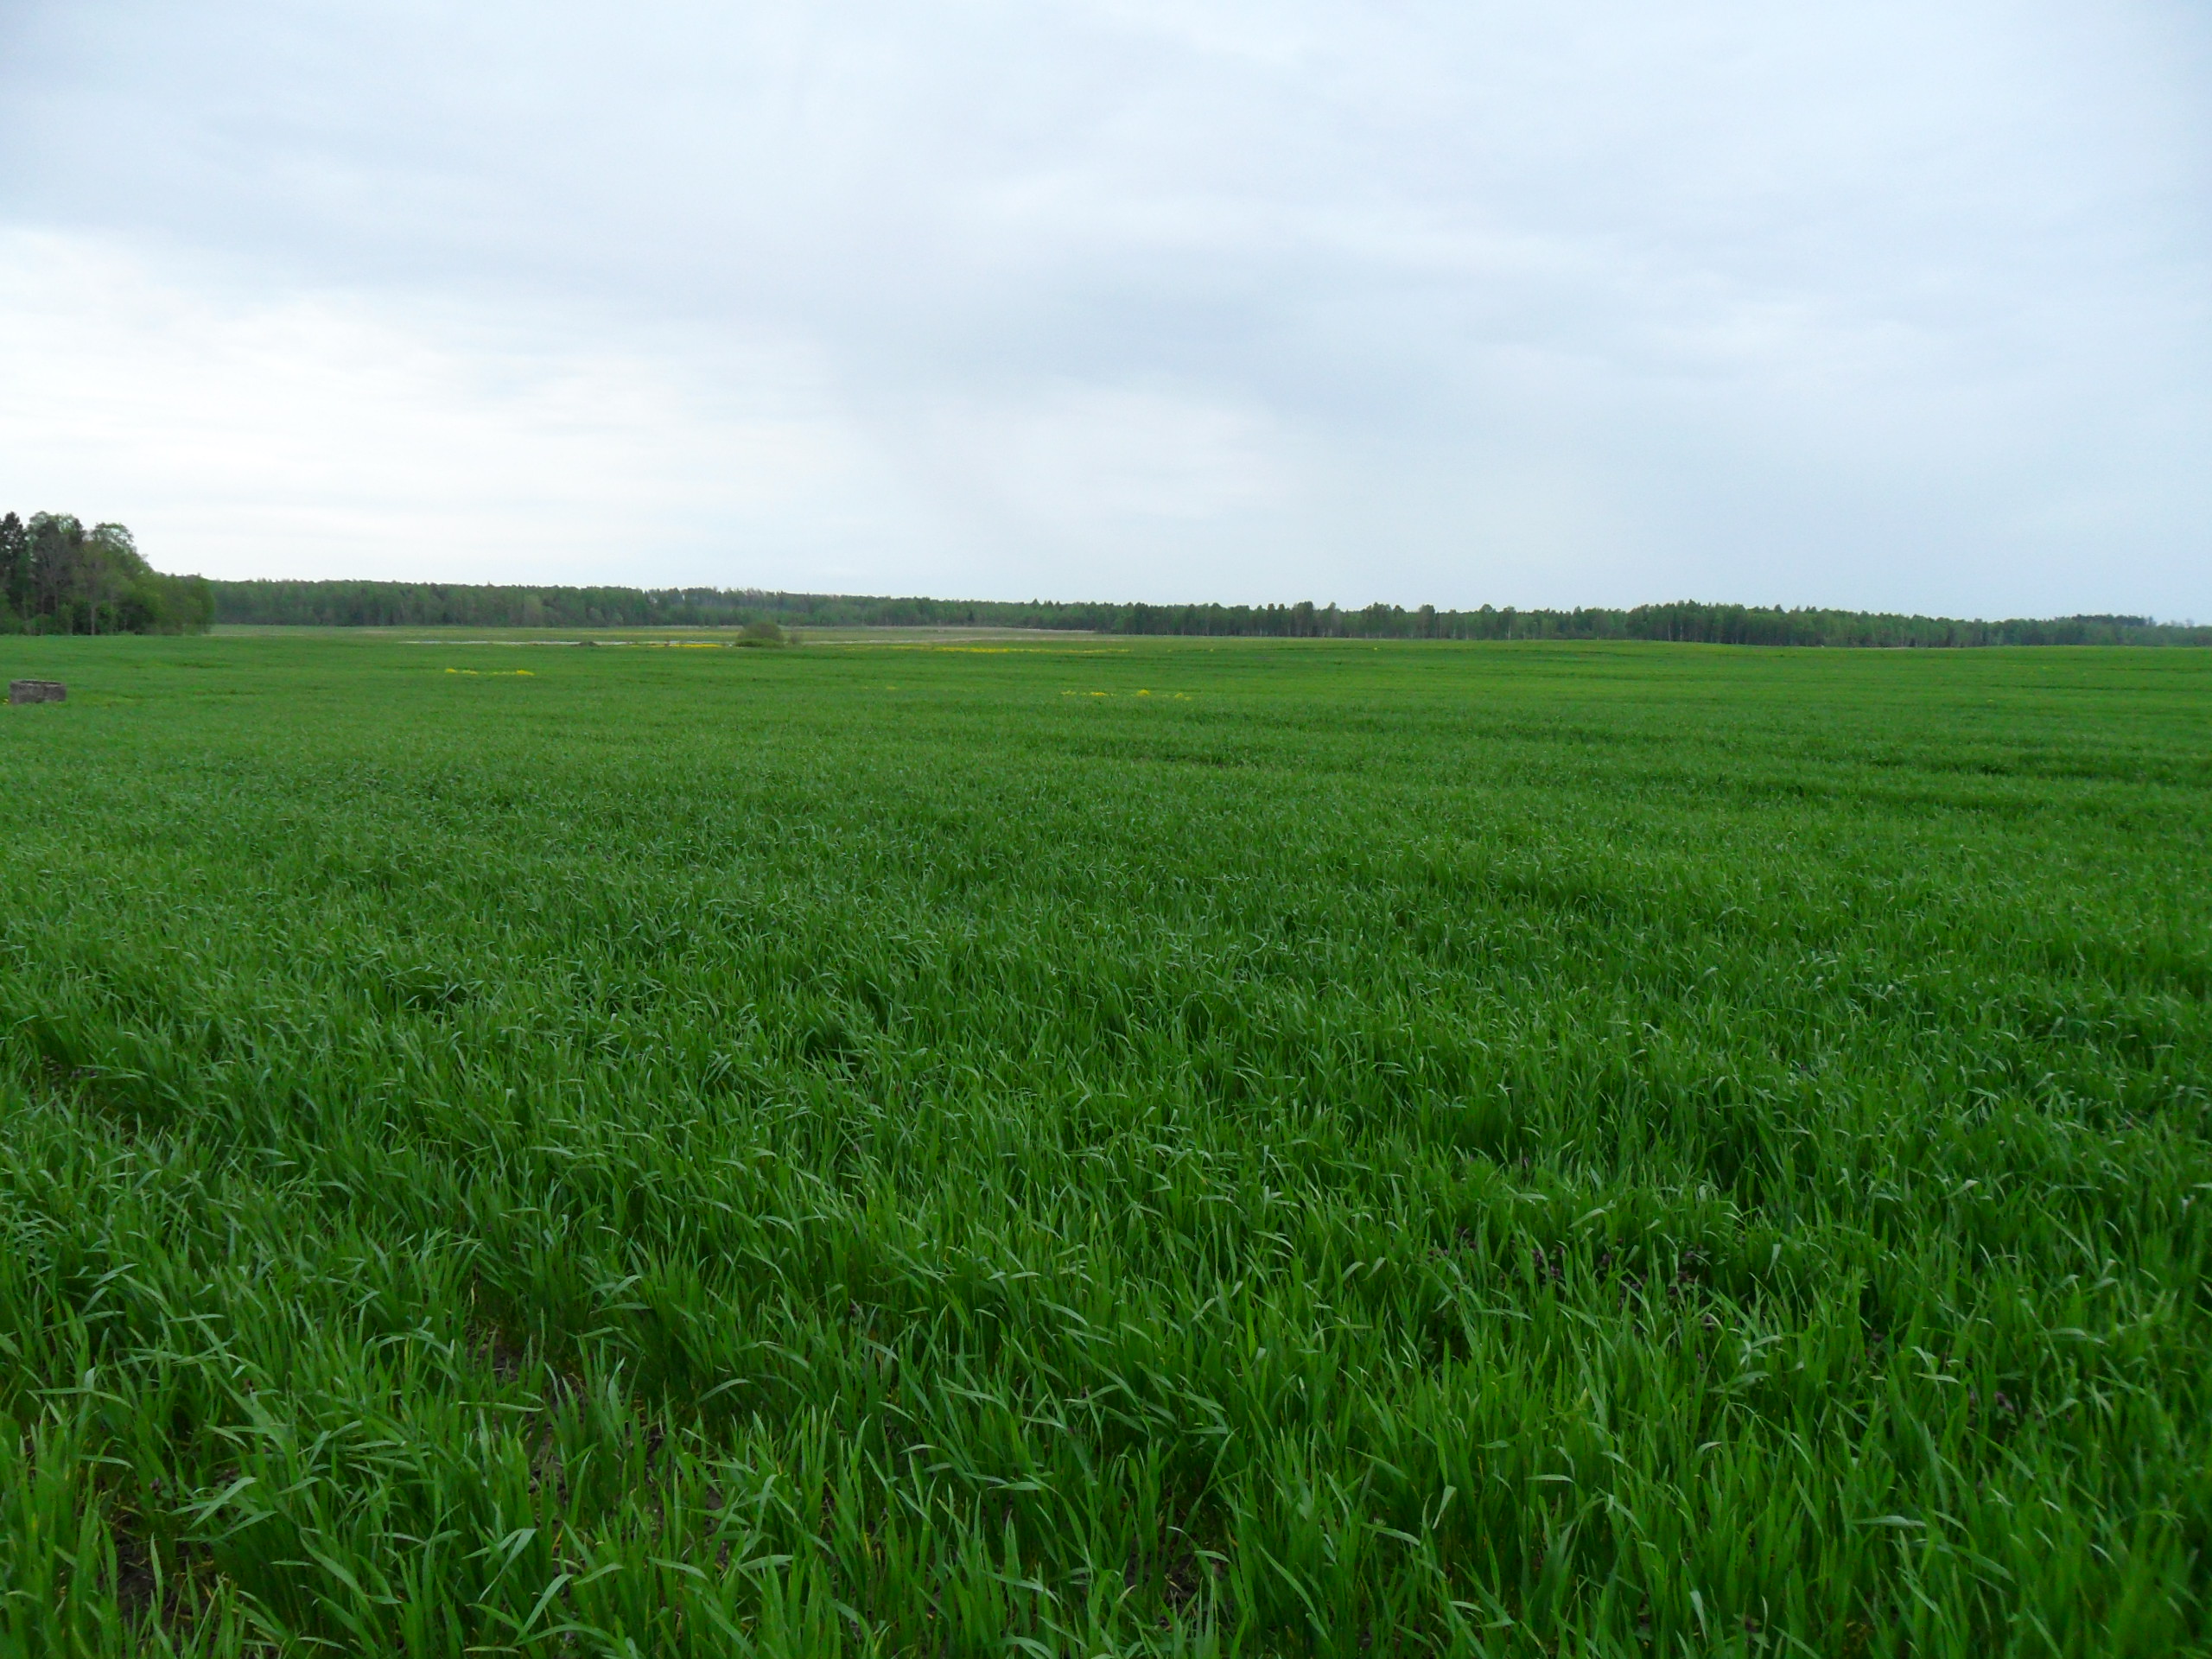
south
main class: Cropland
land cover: Common wheat
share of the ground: > 75 %
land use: Agriculture (excluding fallow land and kitchen gardens)
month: May
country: LV
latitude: 57.2999
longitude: 22.5517
